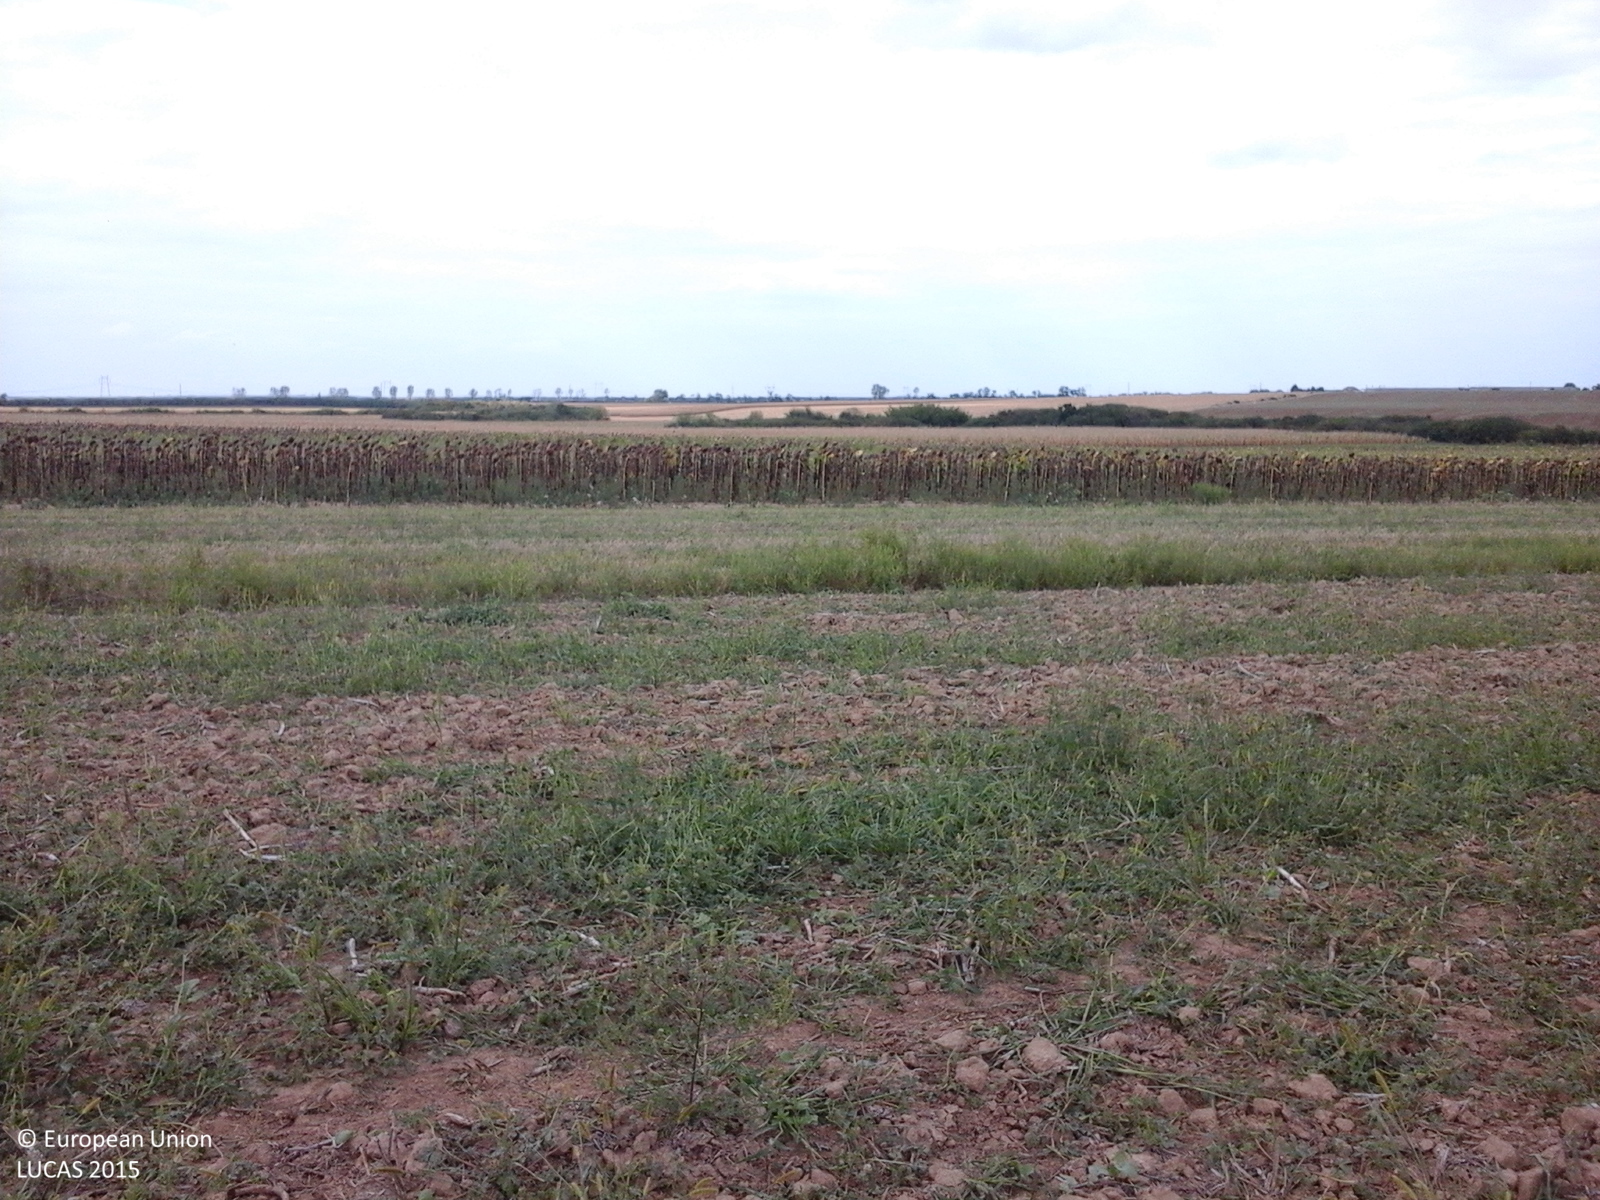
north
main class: Cropland
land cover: Rape and turnip rape
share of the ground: 10 - 25 %
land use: Agriculture (excluding fallow land and kitchen gardens)
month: September
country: RO
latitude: 47.4938
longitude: 22.6291
